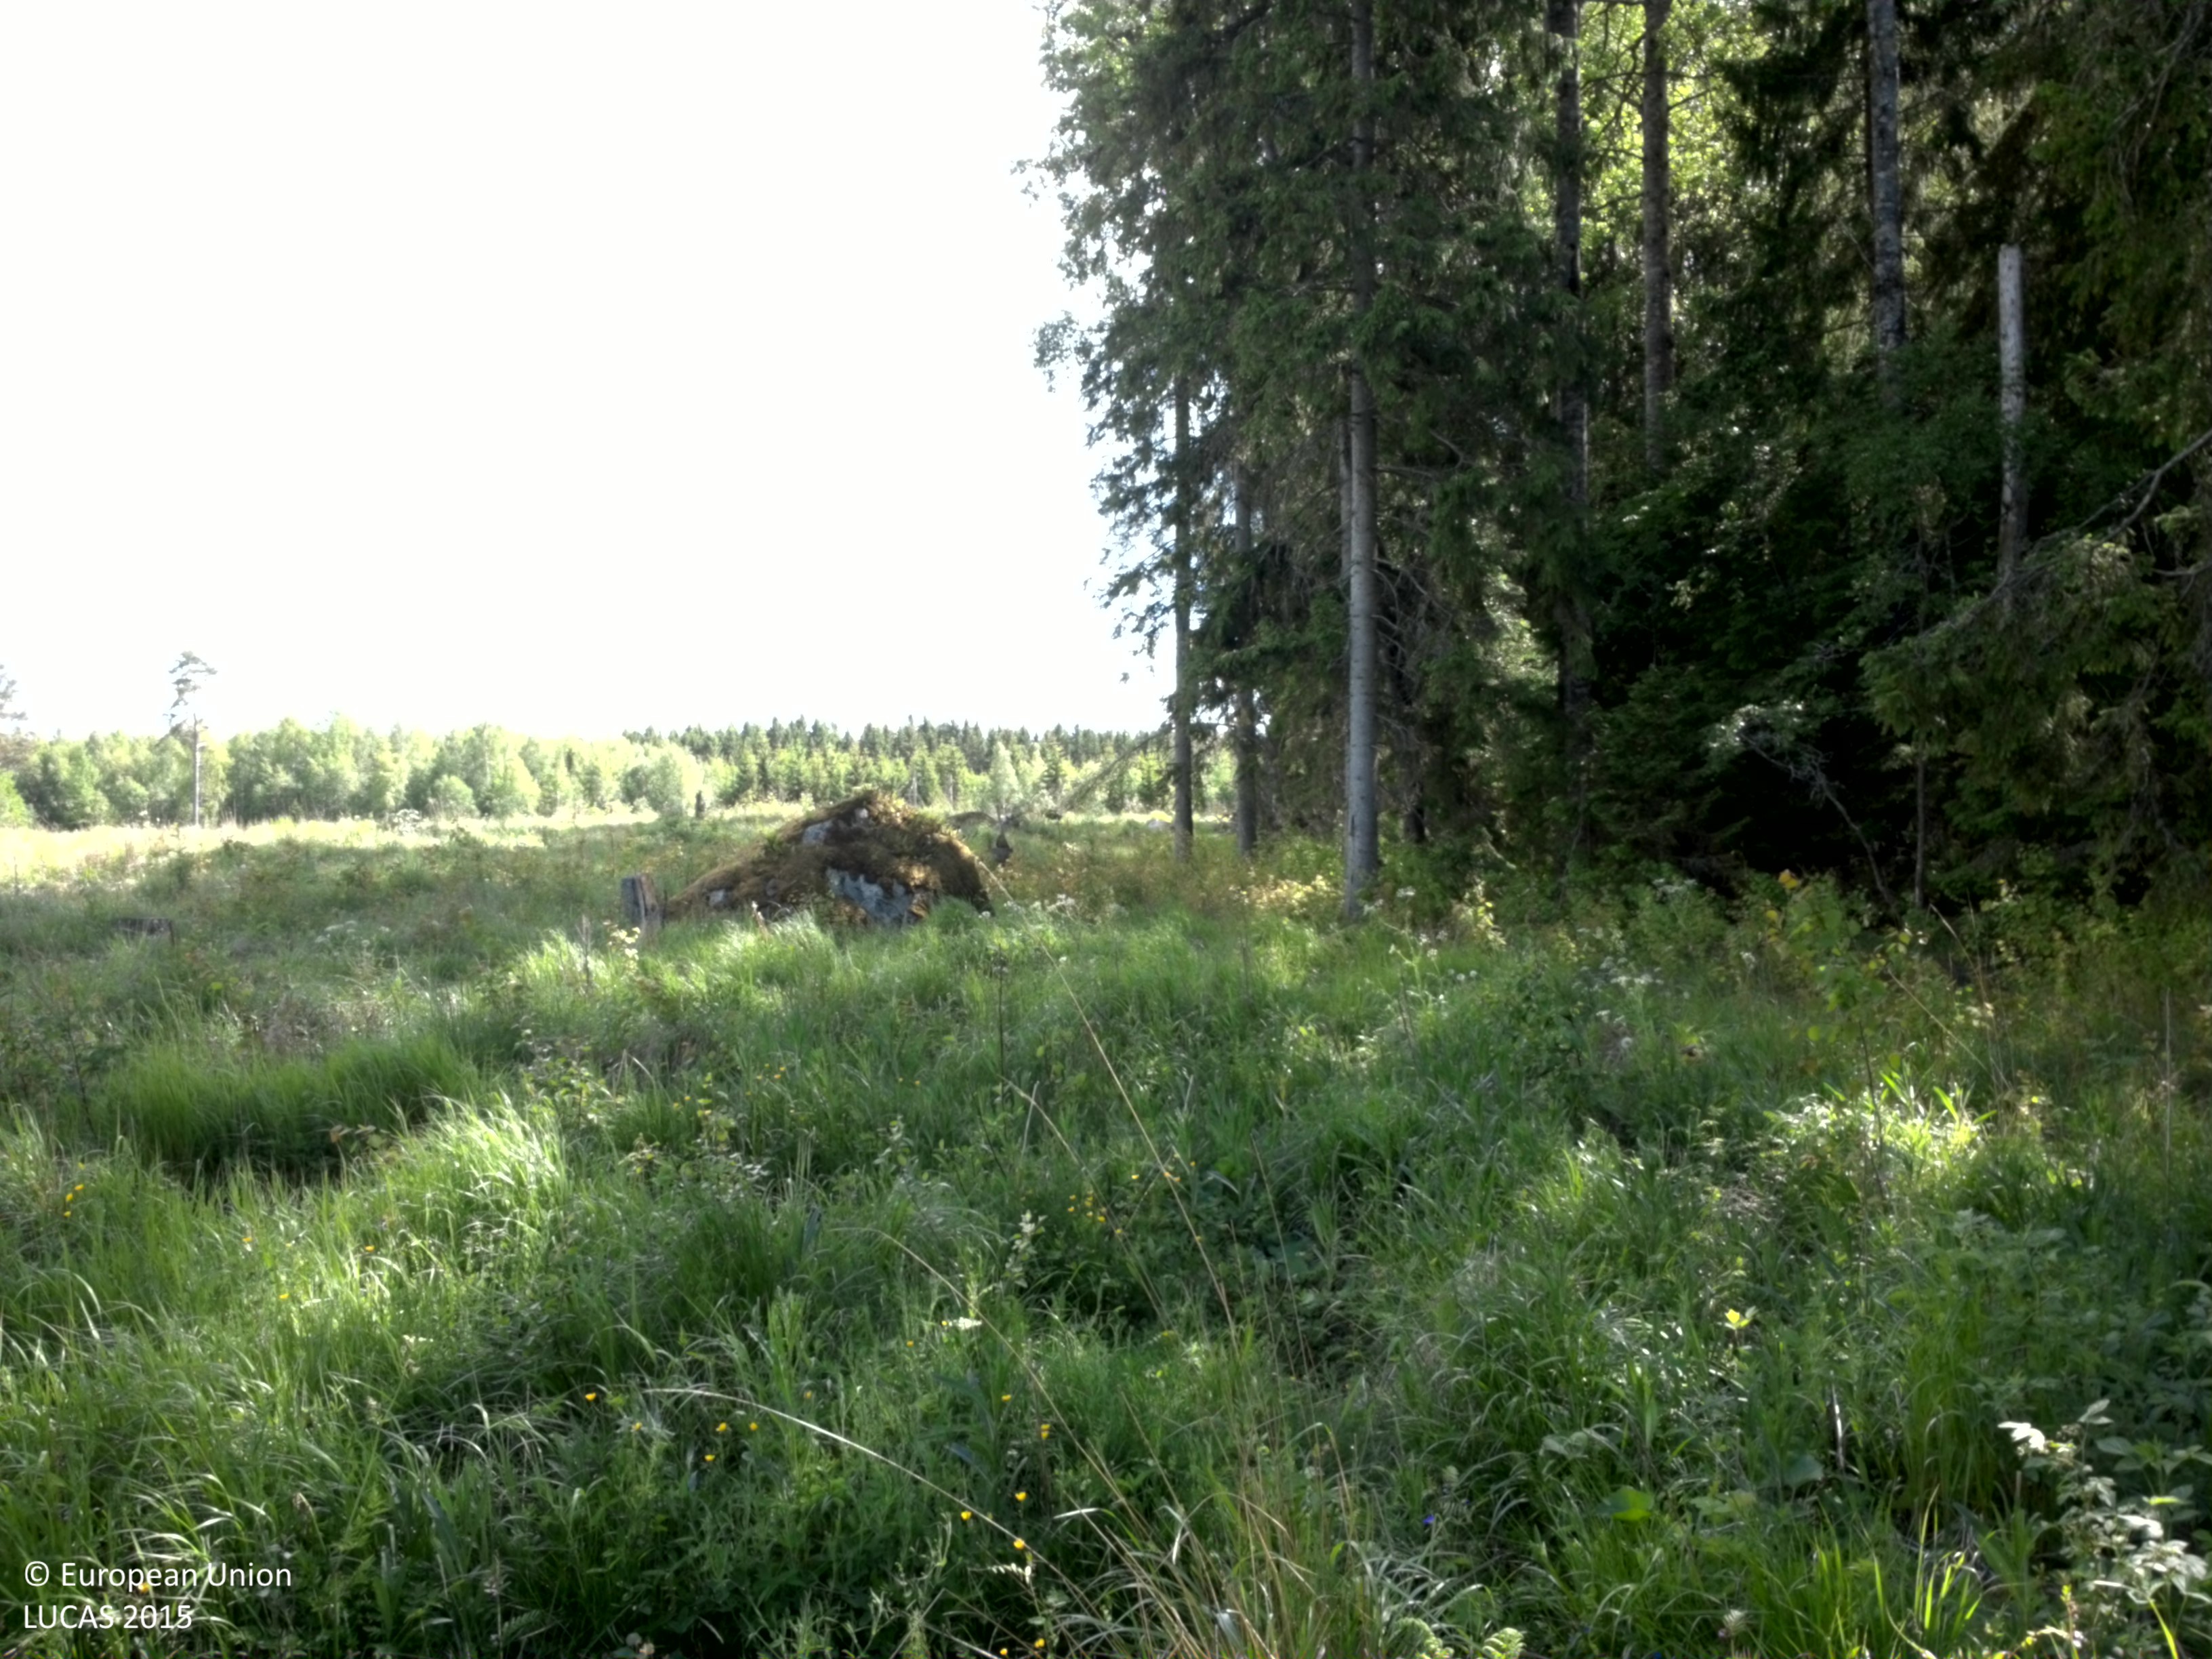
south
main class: Grassland
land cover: Grassland with sparse tree/shrub cover
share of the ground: < 10 %
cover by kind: herbaceous plants 80 %, unconsolidated bare surface 15 %, broadleaved forest trees 5 %
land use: Forestry
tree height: > 5 m
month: June
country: SE
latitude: 60.1838
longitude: 17.0770
